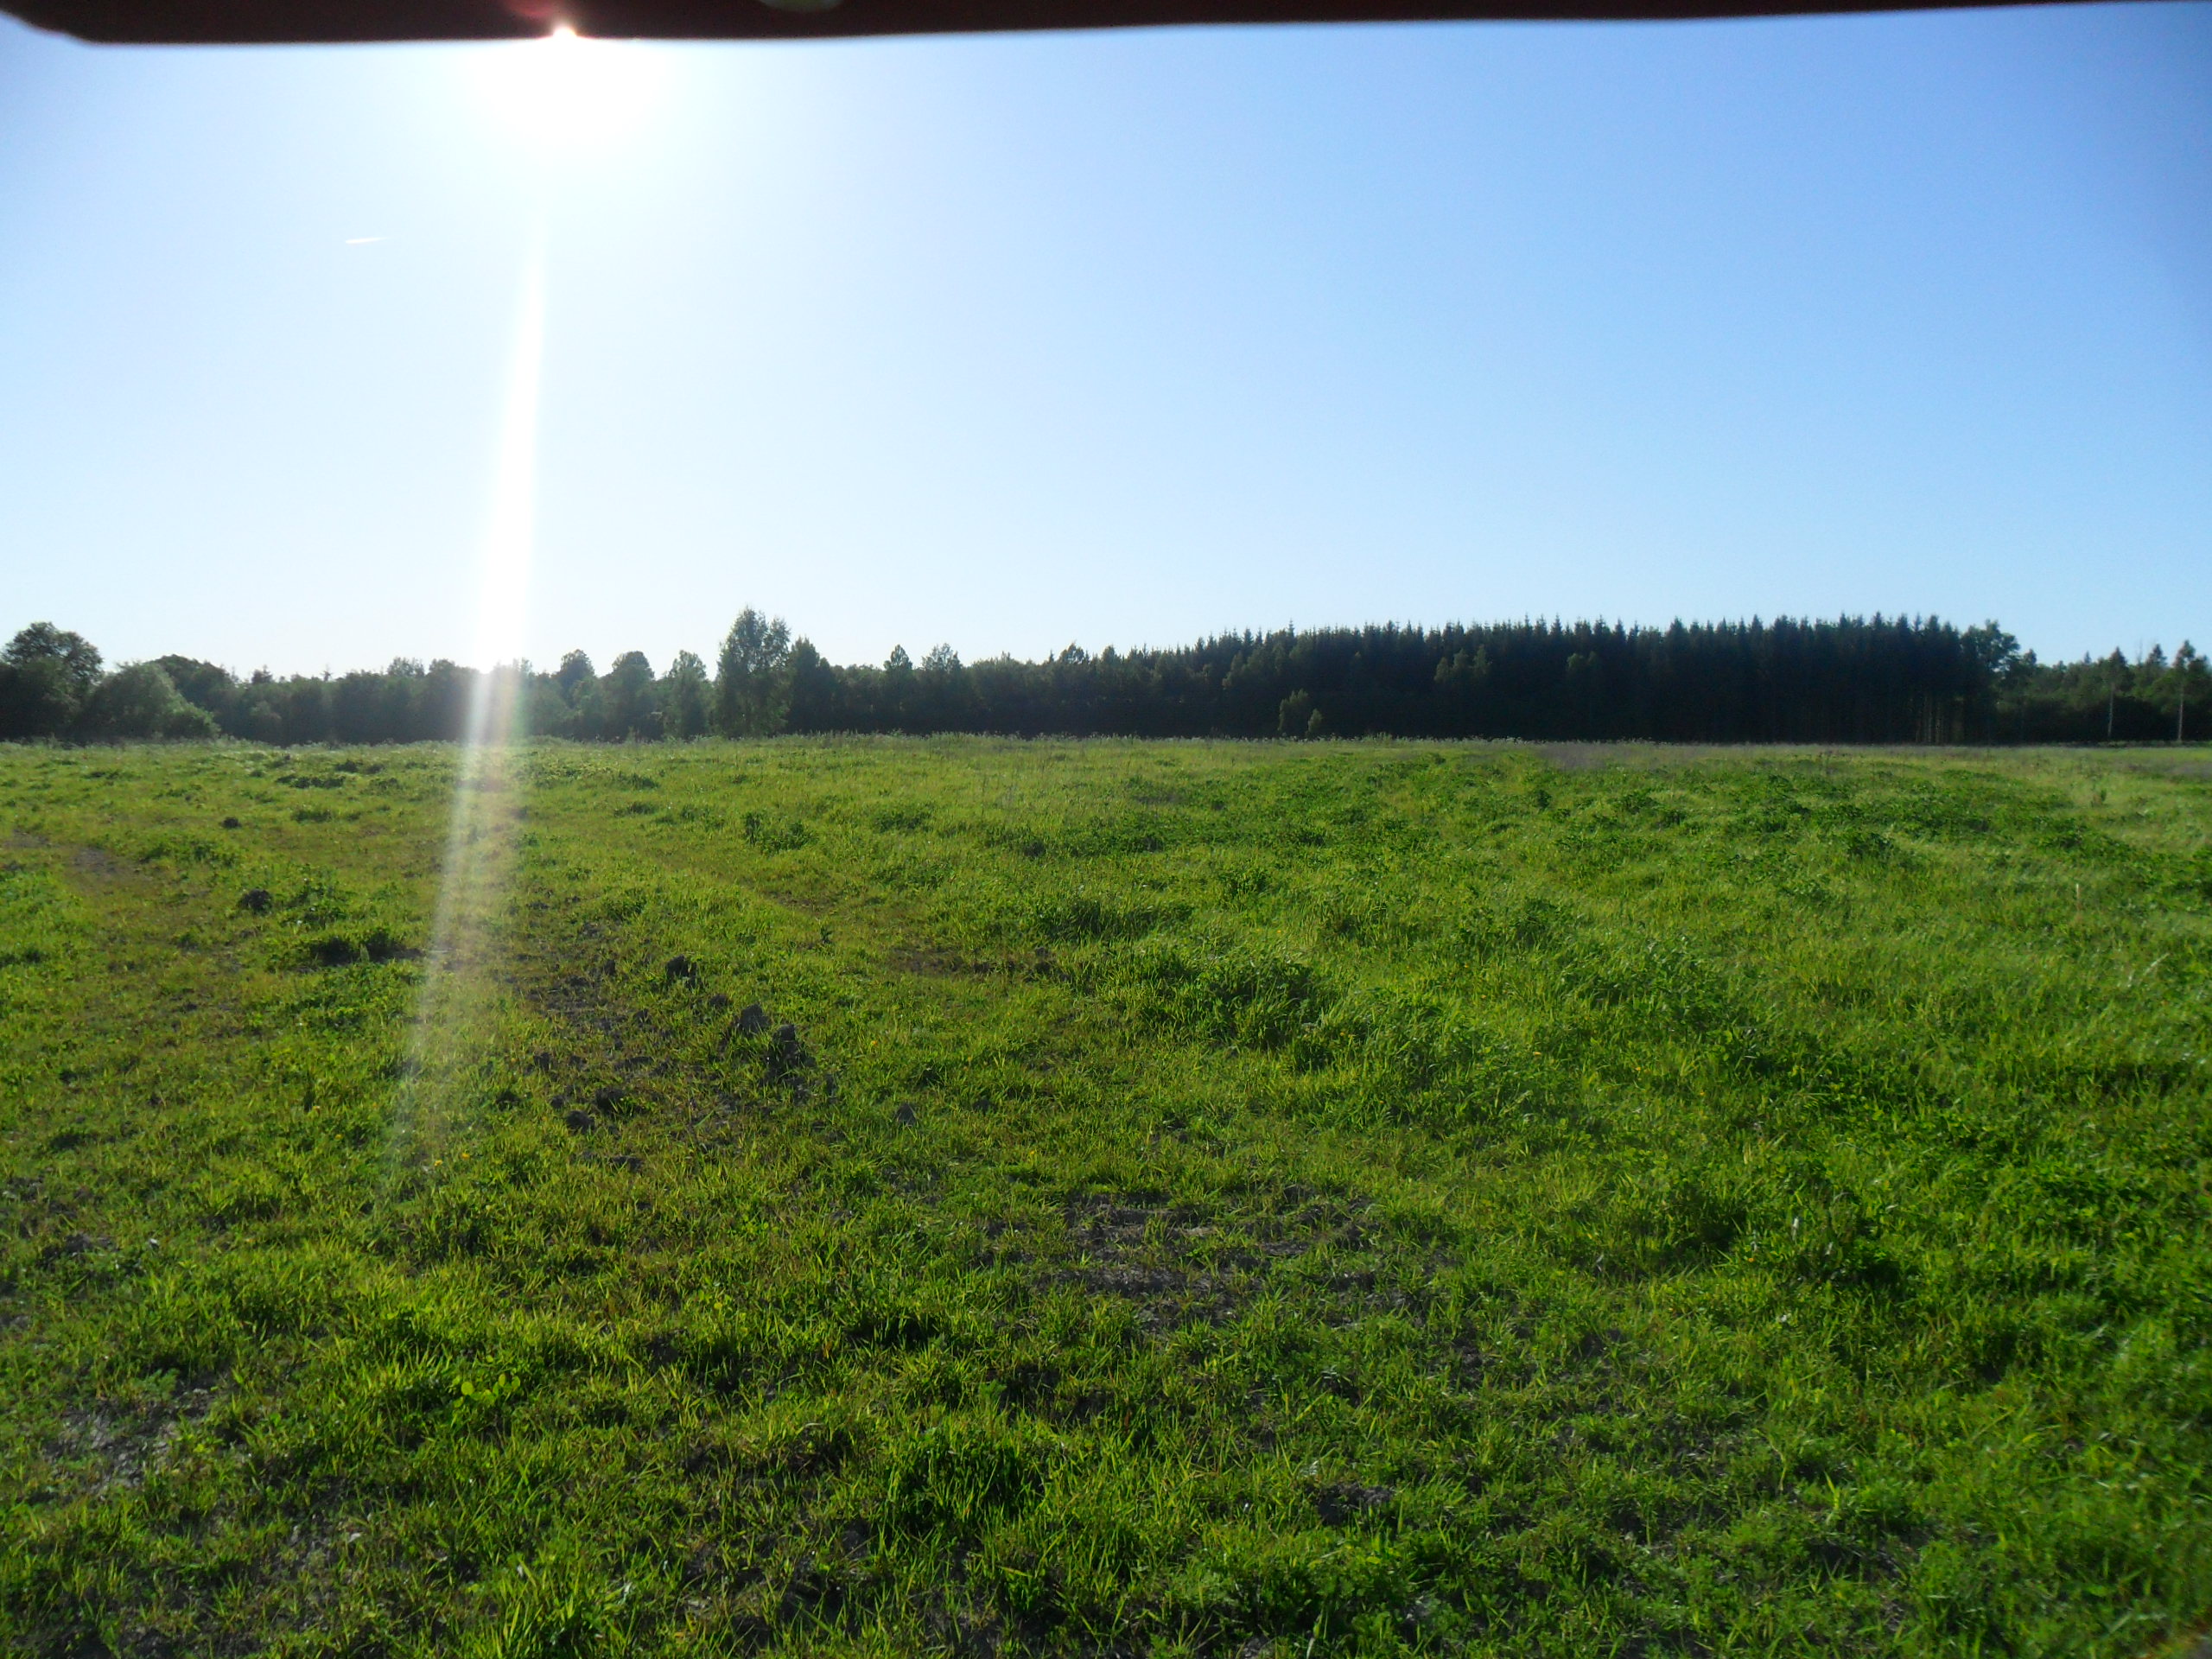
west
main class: Grassland
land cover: Grassland without tree/shrub cover
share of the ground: > 75 %
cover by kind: herbaceous plants 85 %, unconsolidated bare surface 5 %
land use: Agriculture (excluding fallow land and kitchen gardens)
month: June
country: LV
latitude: 57.5752
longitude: 22.3402
